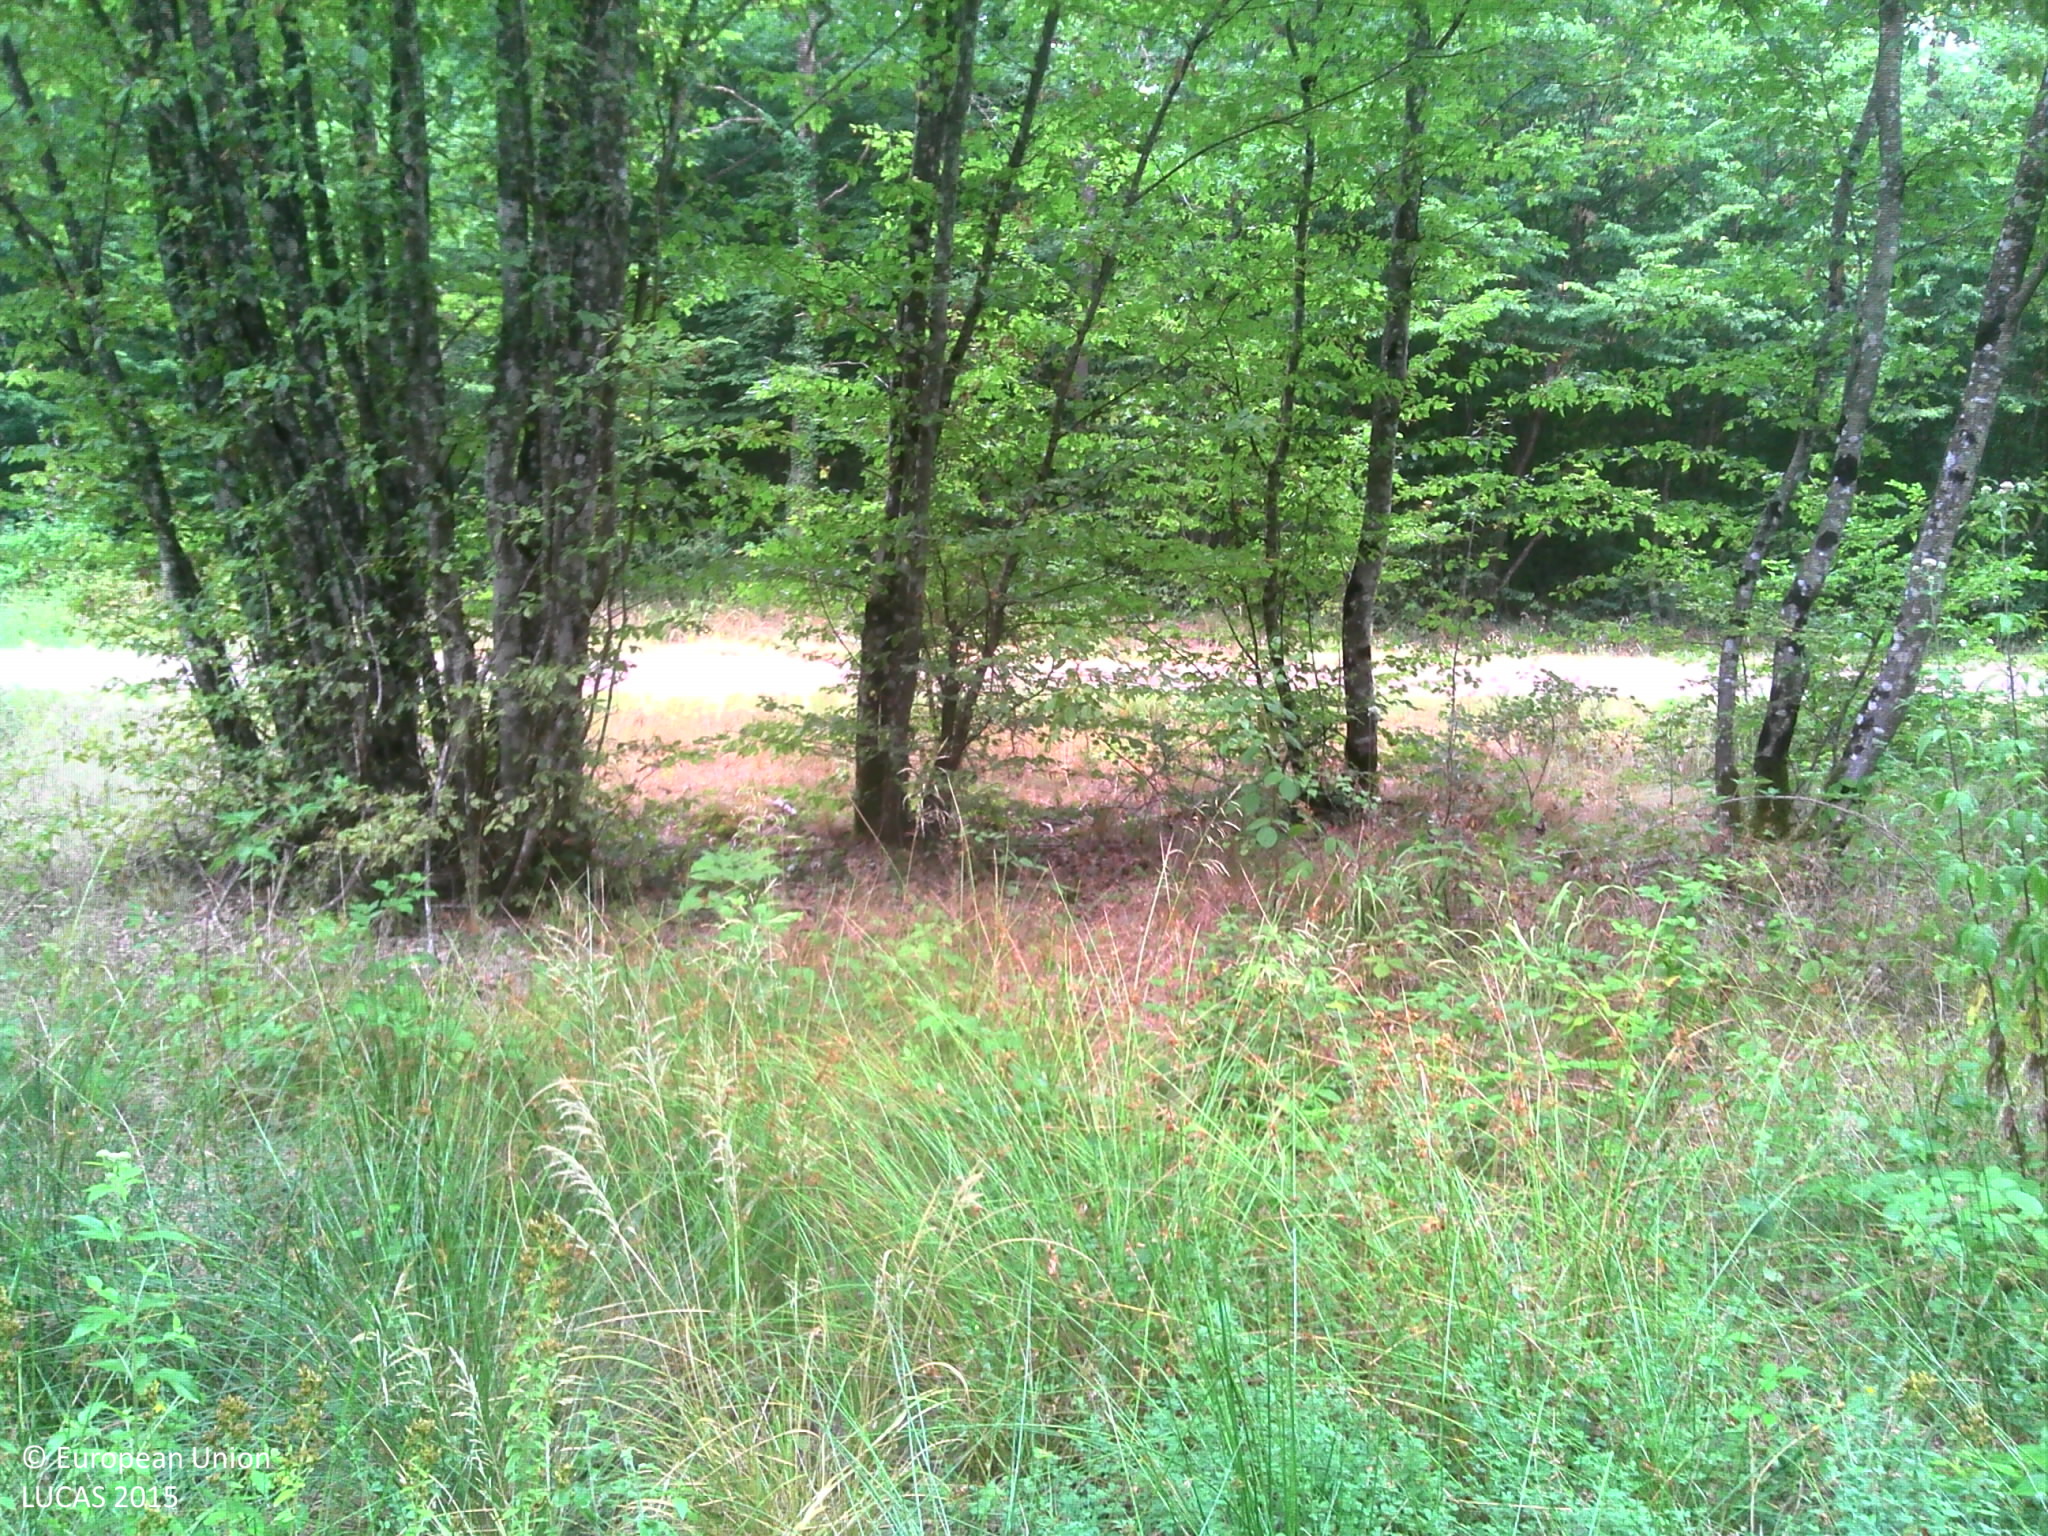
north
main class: Grassland
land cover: Grassland with sparse tree/shrub cover
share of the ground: > 75 %
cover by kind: herbaceous plants 95 %, broadleaved forest trees 5 %
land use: Electricity, gas and thermal power distribution
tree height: > 5 m
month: July
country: FR
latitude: 46.8920
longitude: 4.7904
